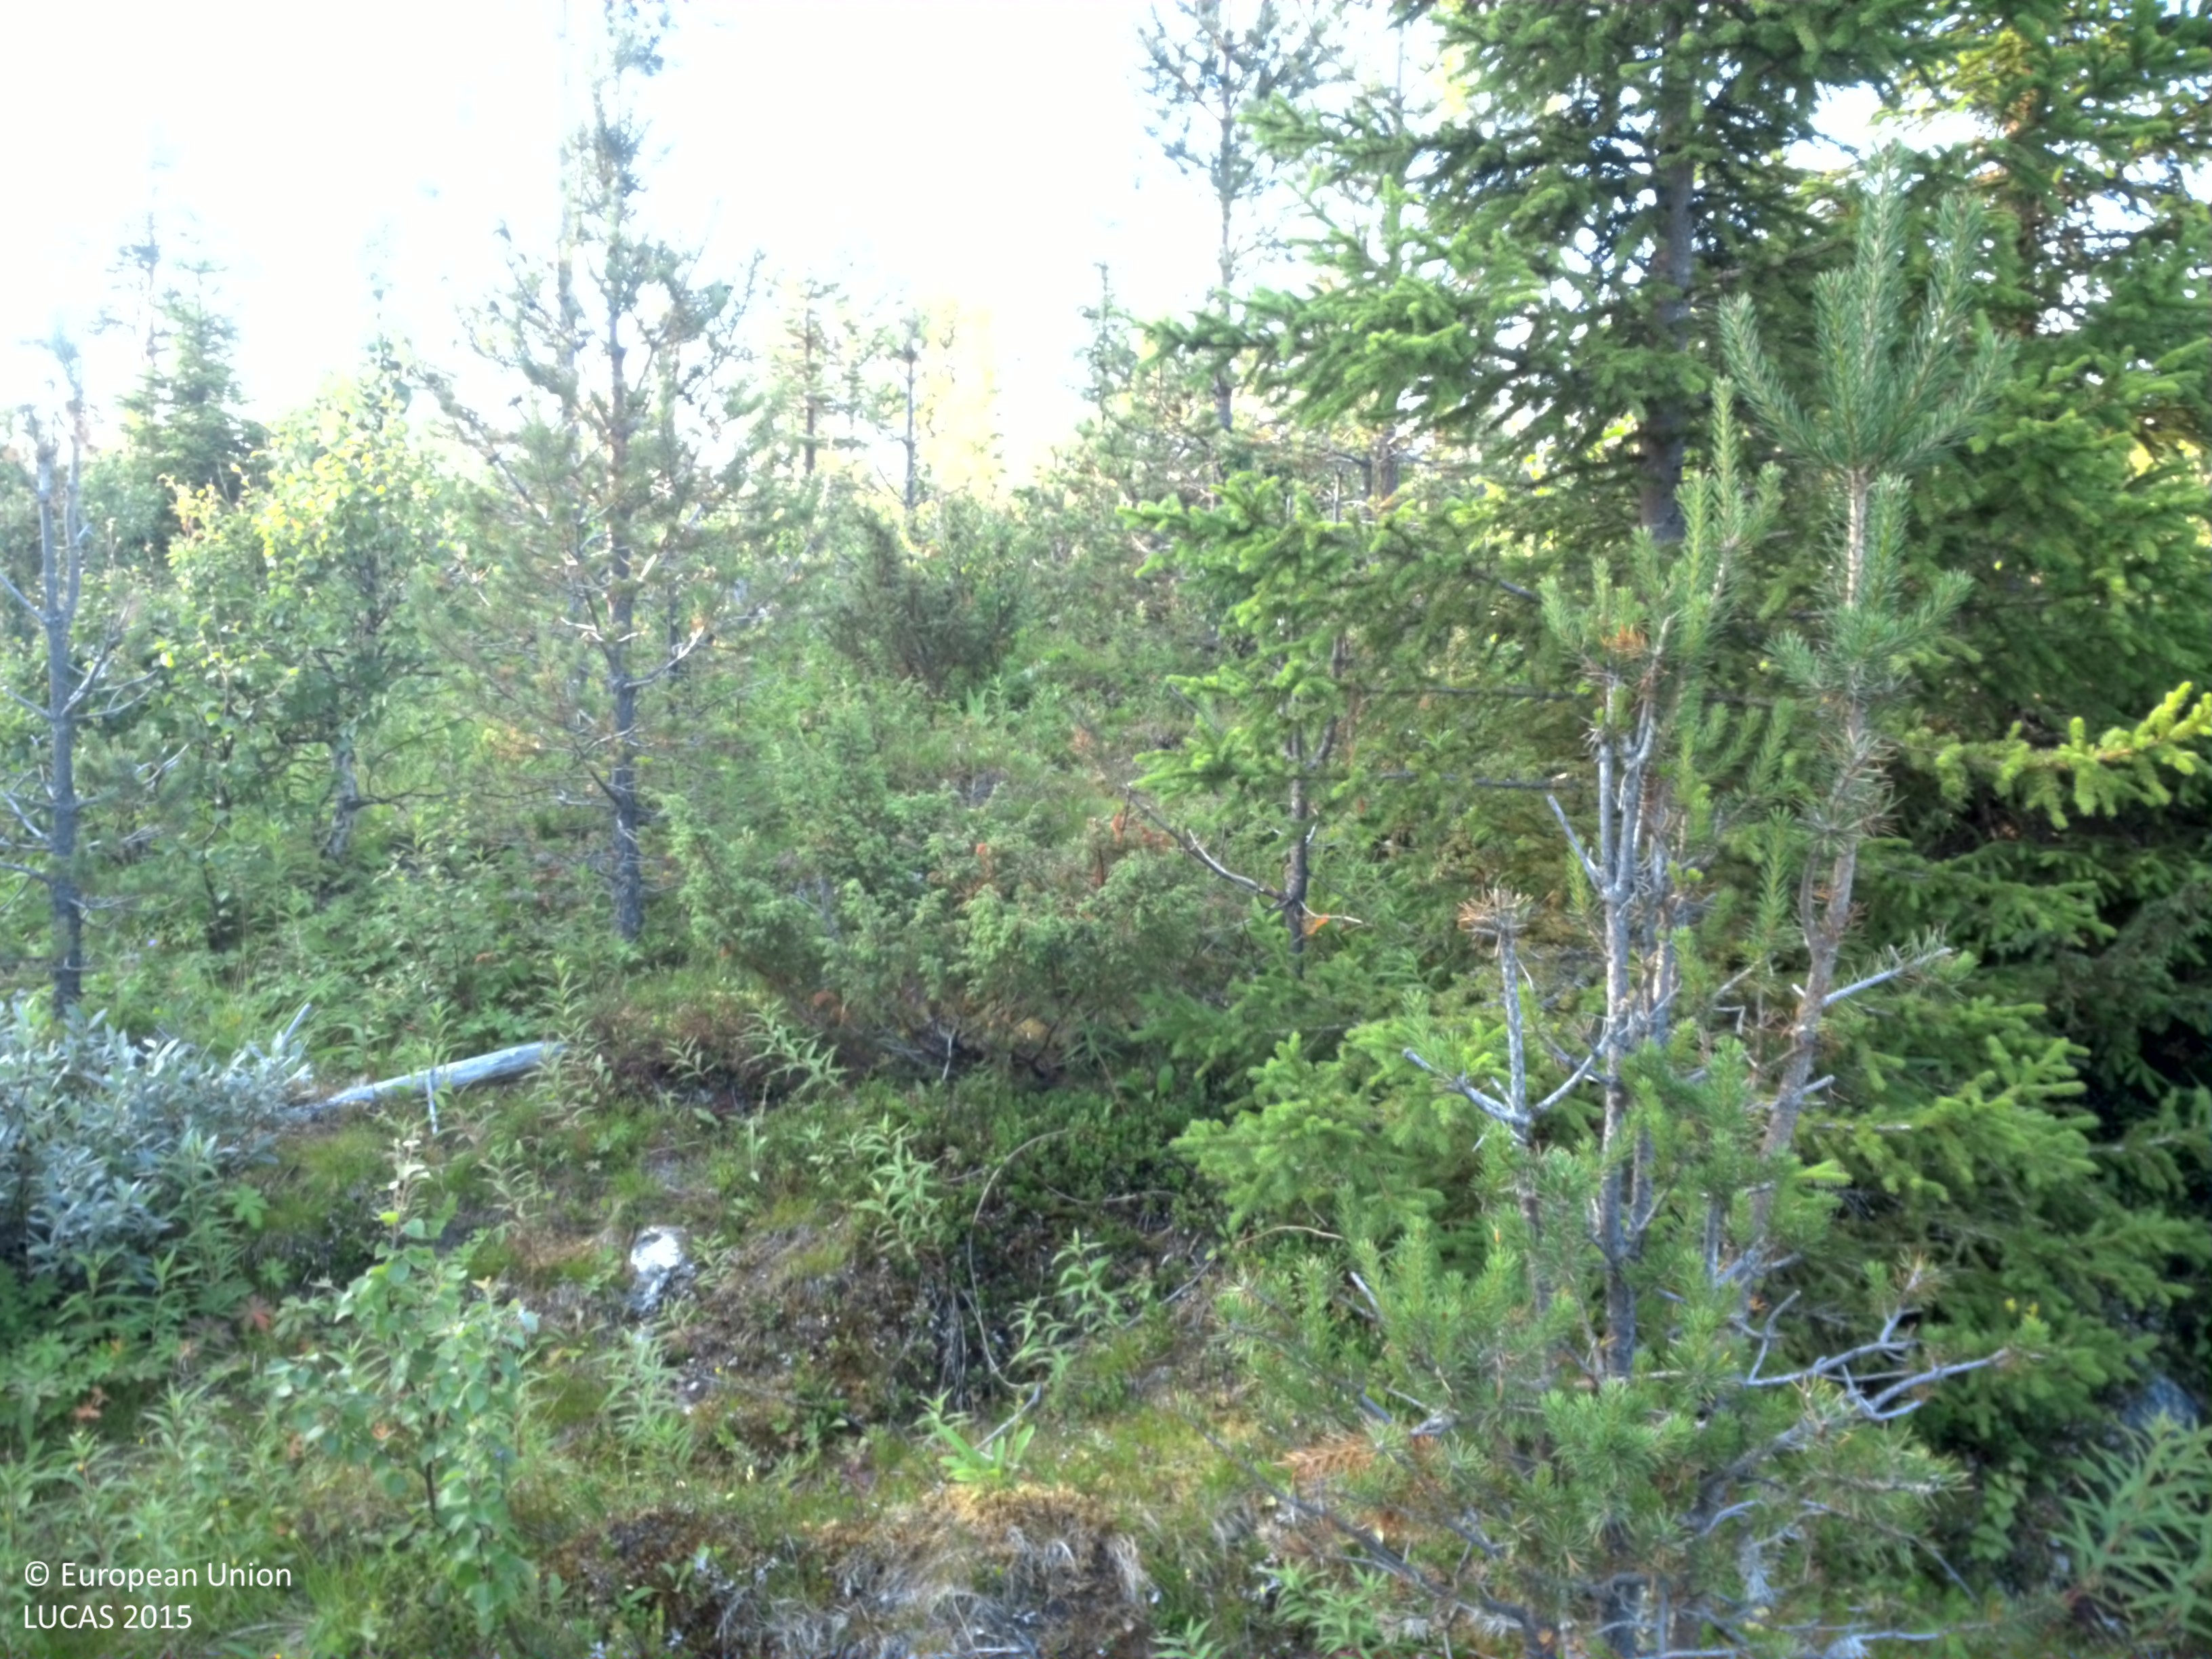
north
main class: Woodland
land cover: Other mixed woodland
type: boreal forest
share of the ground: 10 - 25 %
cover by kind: herbaceous plants 60 %, shrubs 20 %, coniferous forest trees 10 %, broadleaved forest trees 5 %, lichens and mosses 5 %
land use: Forestry
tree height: > 5 m
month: August
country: SE
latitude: 65.0714
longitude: 16.2800
